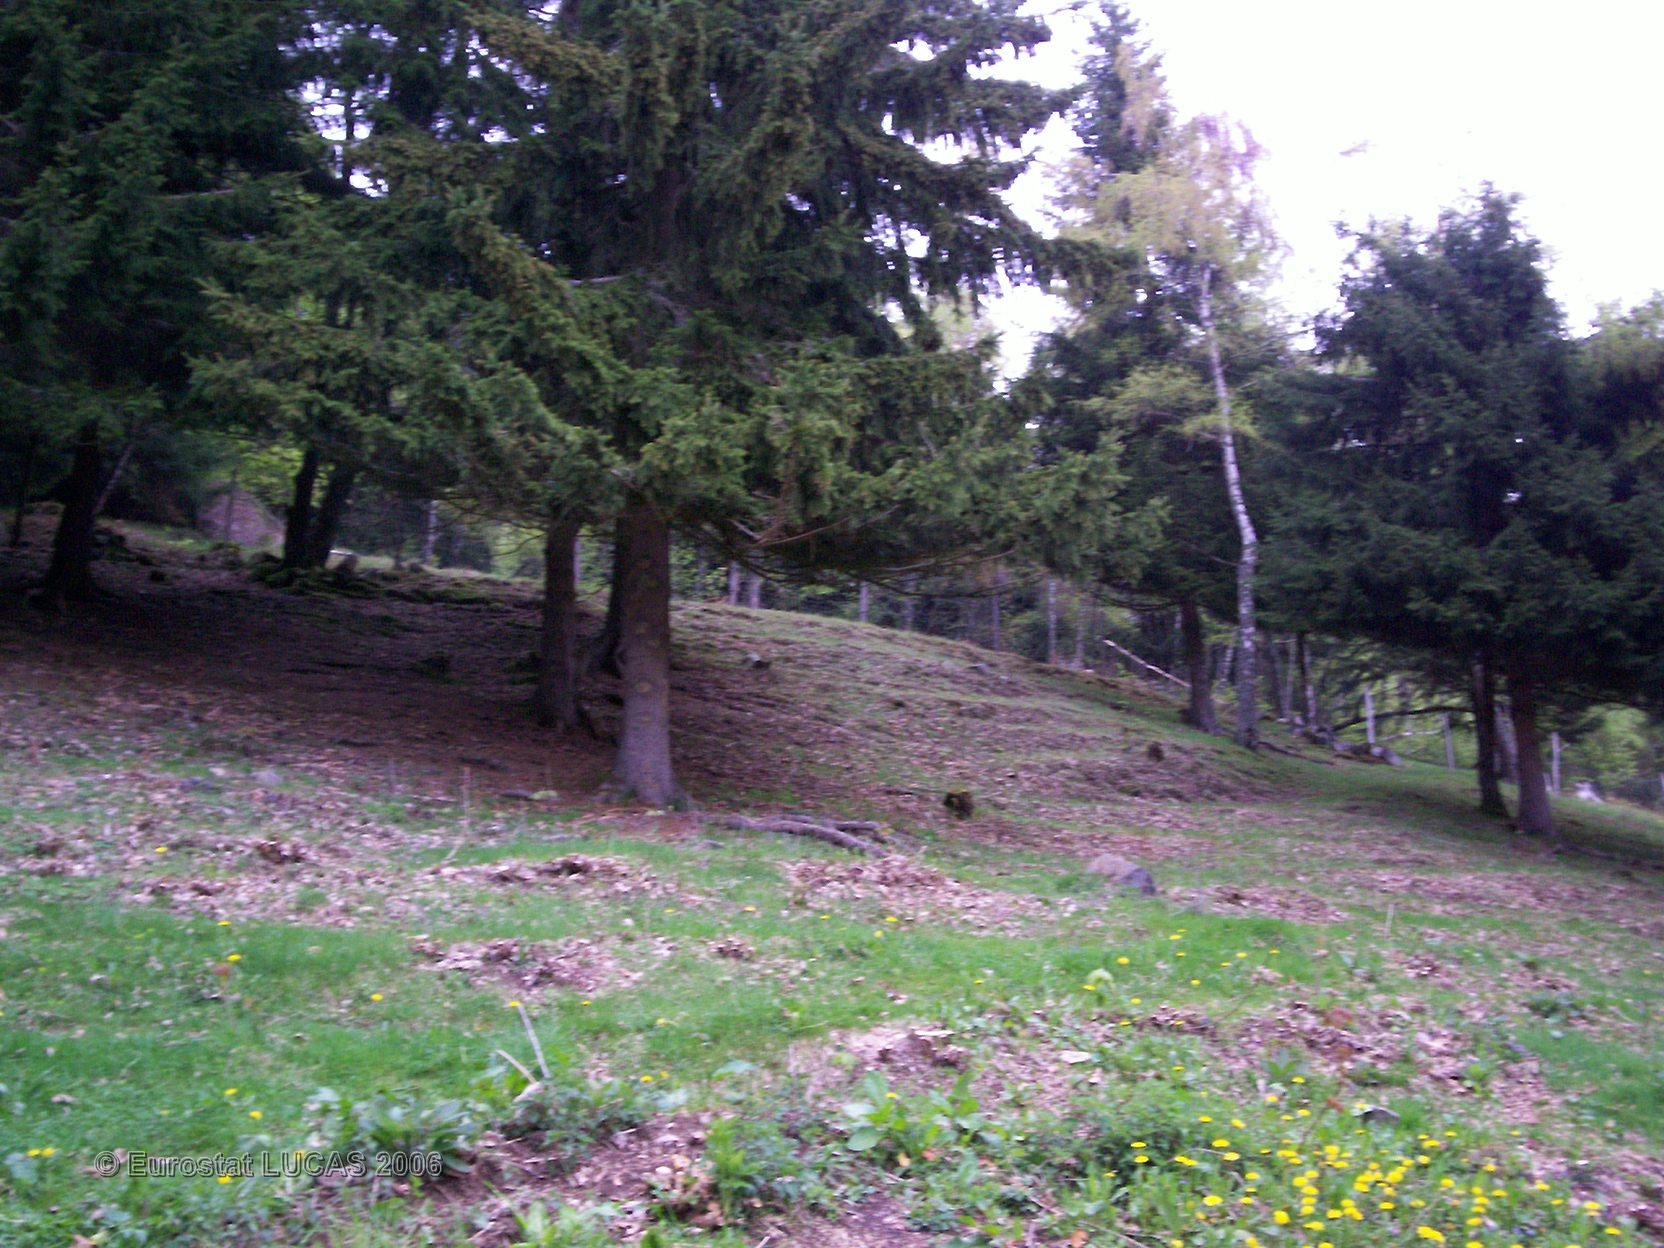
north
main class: Grassland
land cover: Grassland with sparse tree/shrub cover
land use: Agriculture (excluding fallow land and kitchen gardens)
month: May
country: FR
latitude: 47.9512
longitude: 7.0956
